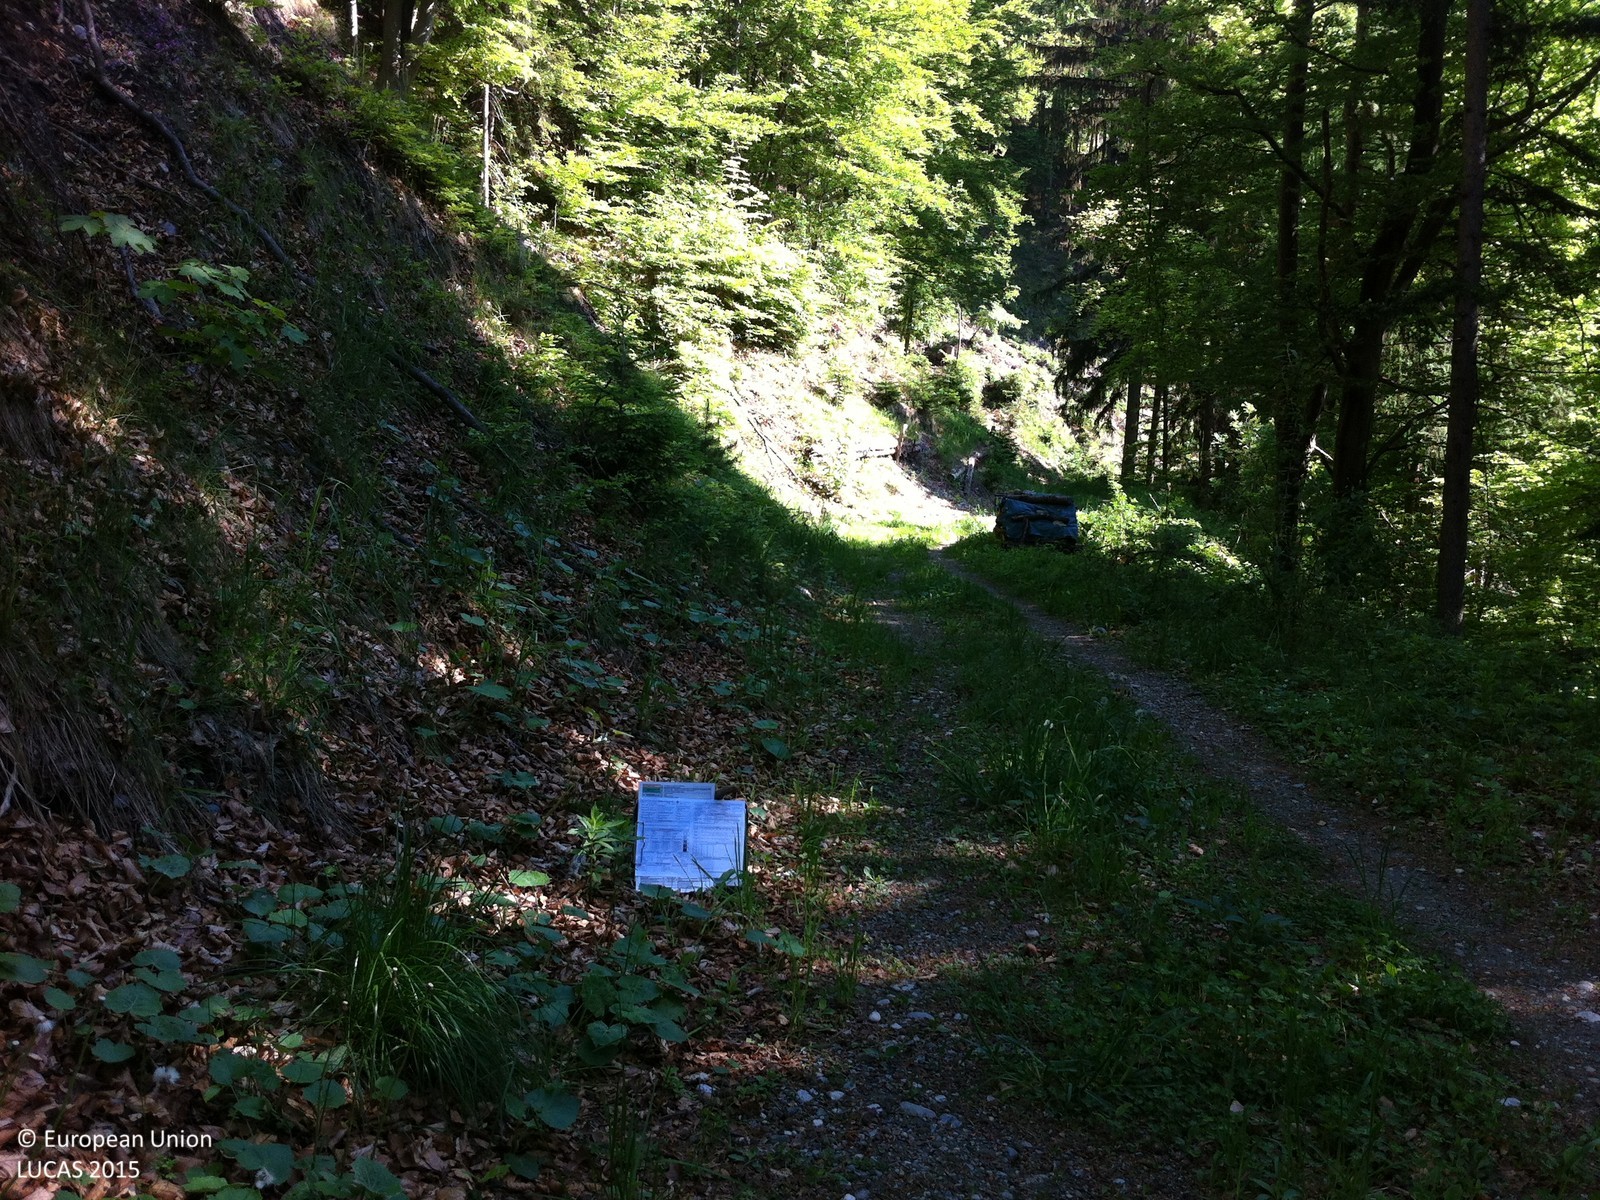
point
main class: Grassland
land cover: Spontaneously vegetated surfaces
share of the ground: > 75 %
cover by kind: herbaceous plants 70 %, unconsolidated bare surface 30 %
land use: Forestry
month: May
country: AT
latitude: 47.3642
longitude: 11.7067
